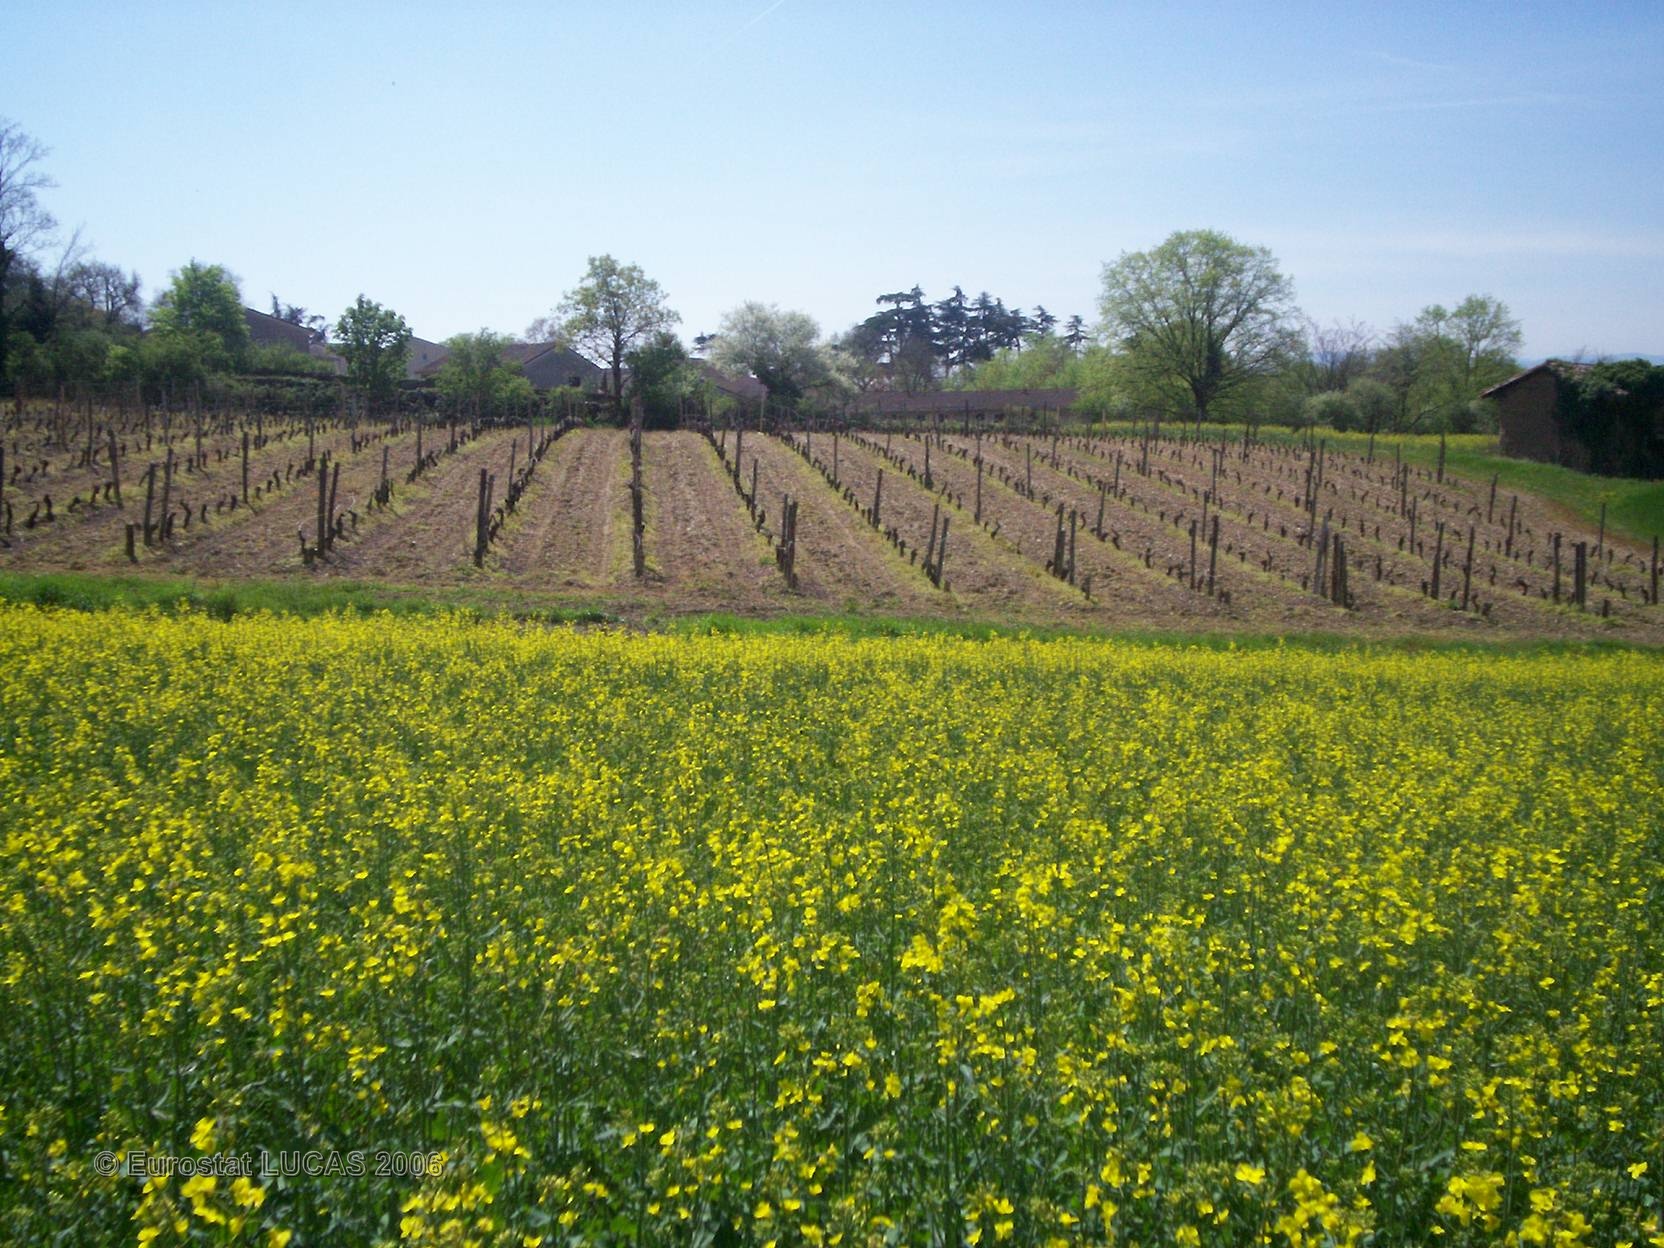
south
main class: Cropland
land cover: Rape and turnip rape
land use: Agriculture (excluding fallow land and kitchen gardens)
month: April
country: FR
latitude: 45.4473
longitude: 4.7749
